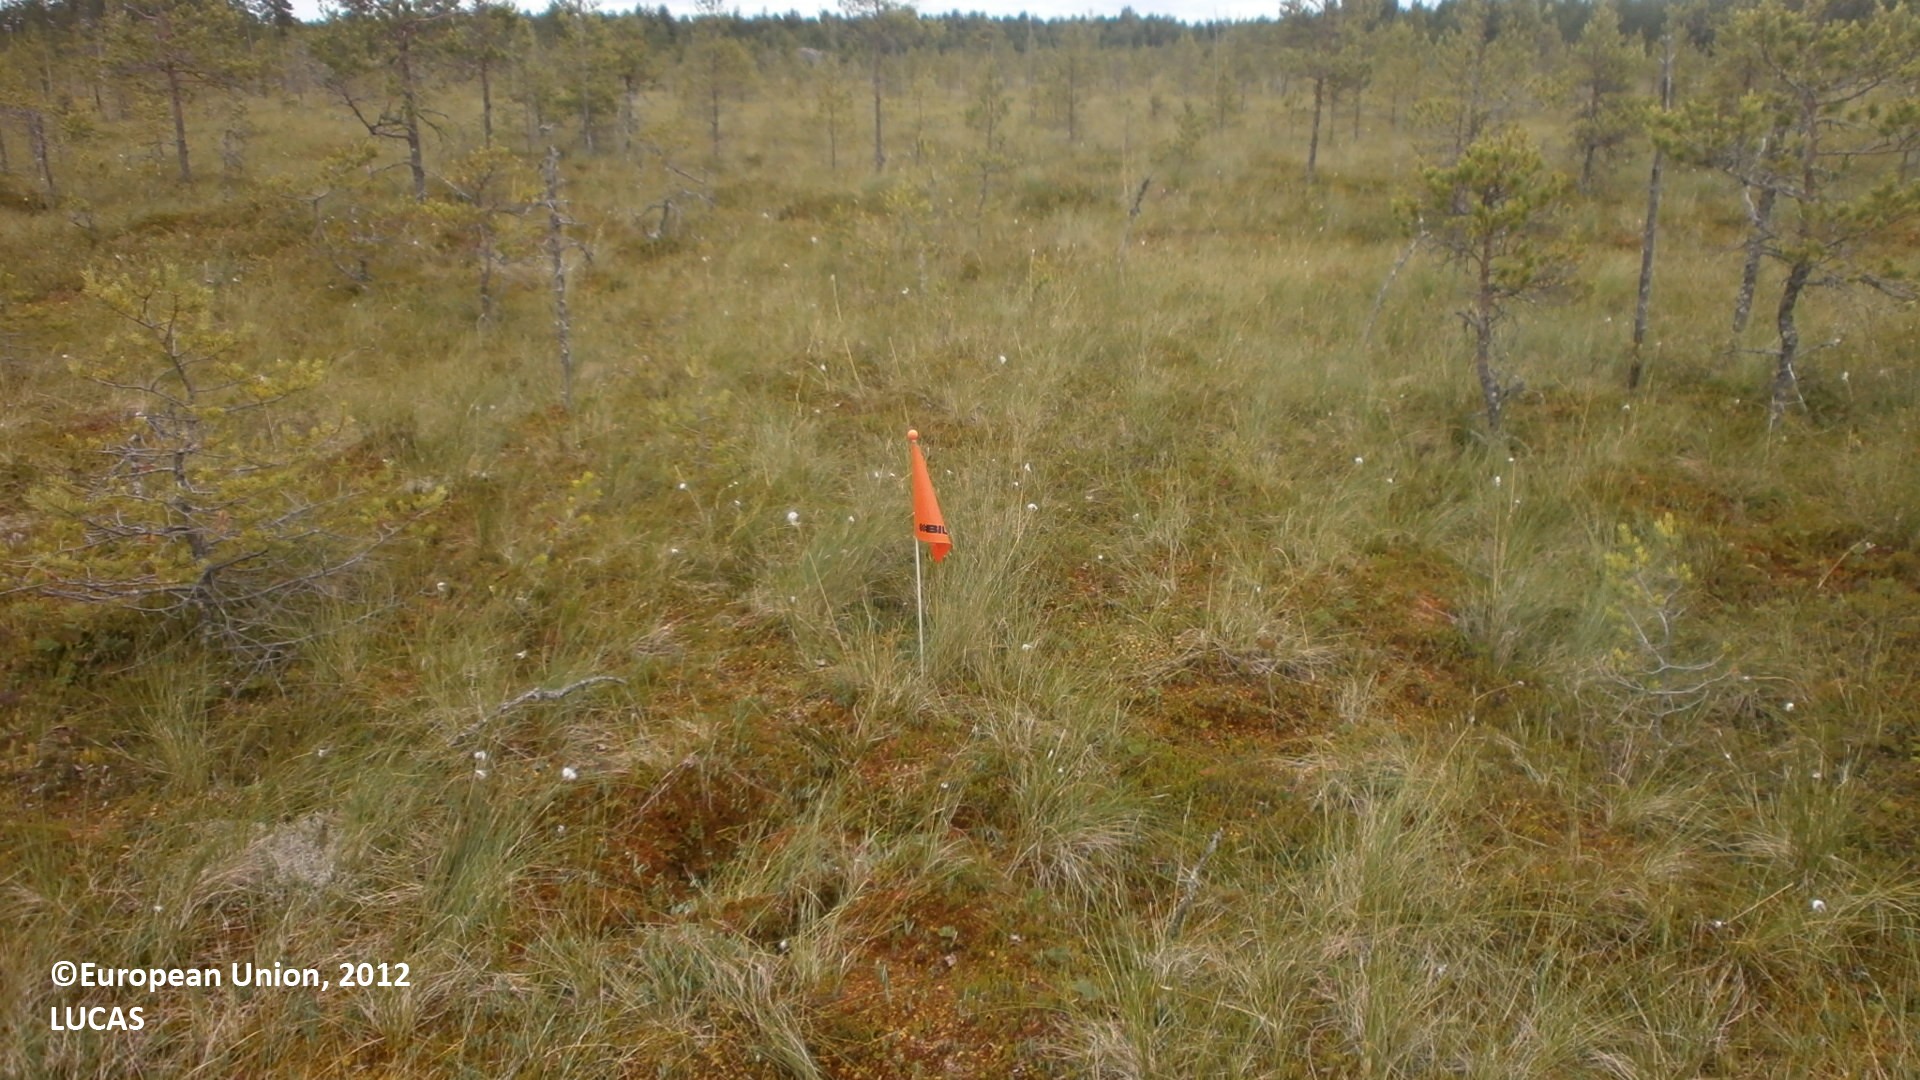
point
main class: Woodland
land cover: Pine dominated coniferous woodland
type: mire and swamp forests
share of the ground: 10 - 25 %
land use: Semi-natural and natural areas not in use
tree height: < 5 m
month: July
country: FI
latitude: 64.0267
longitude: 24.2522
